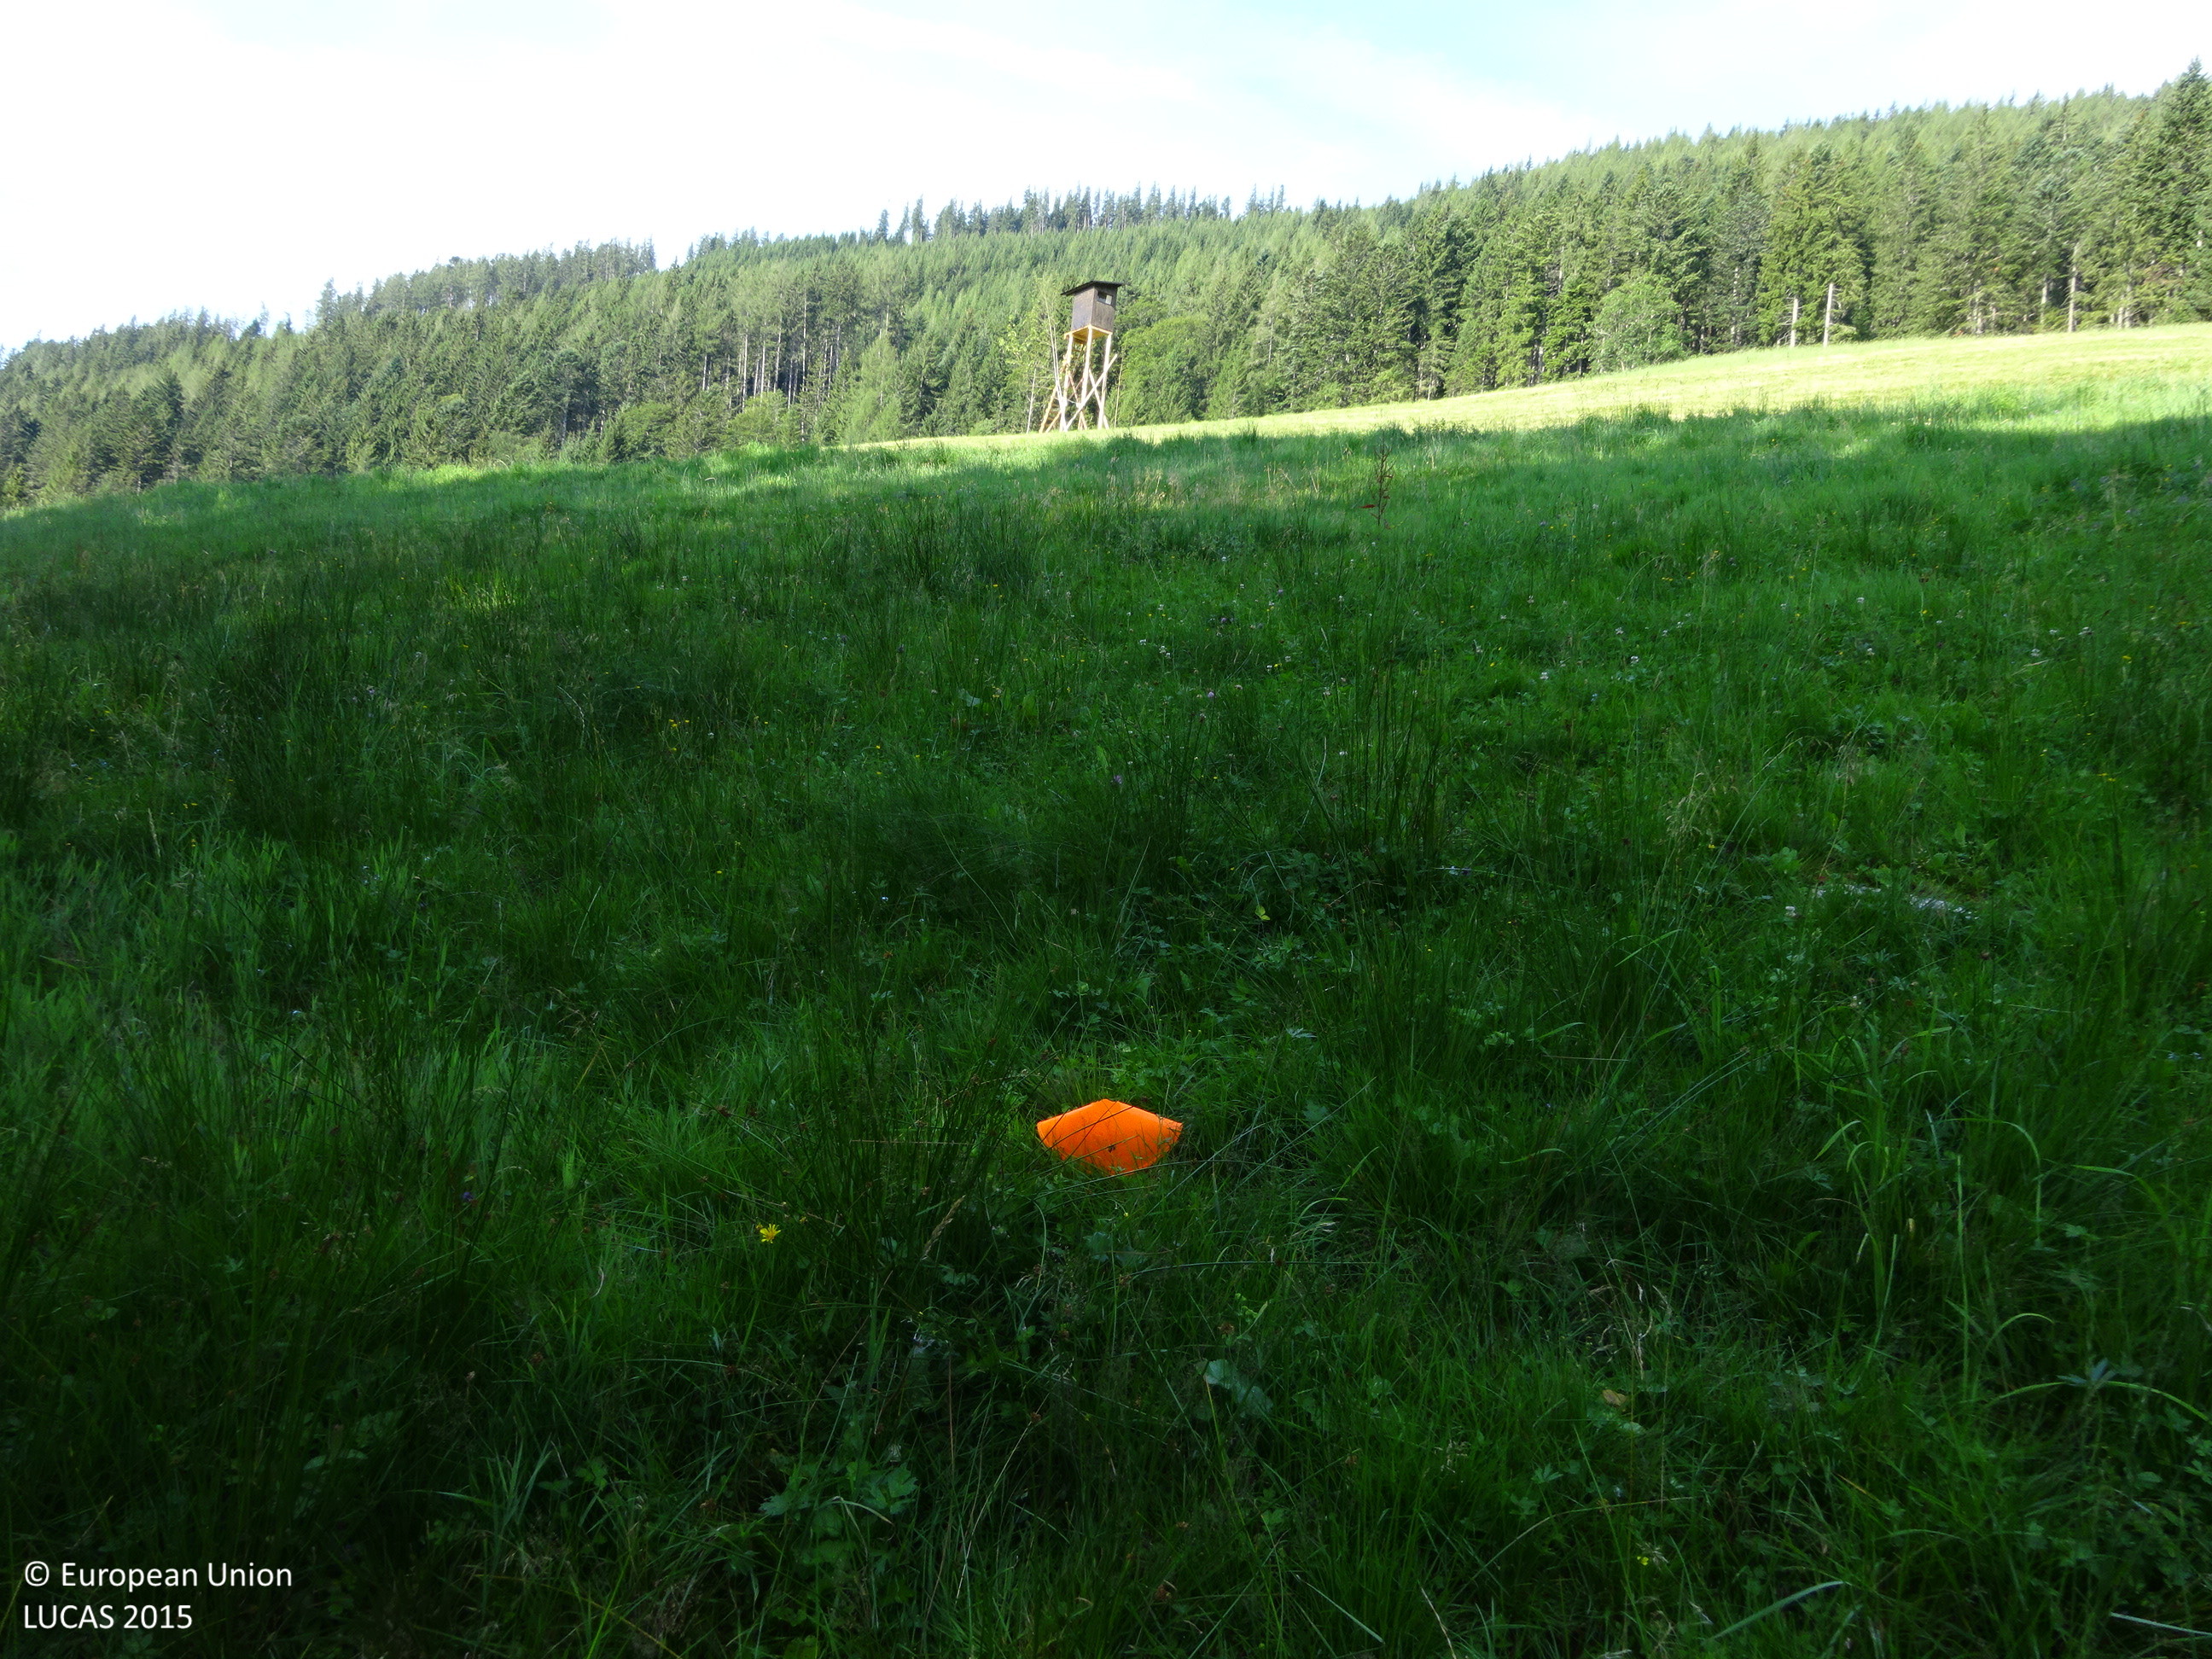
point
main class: Grassland
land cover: Grassland without tree/shrub cover
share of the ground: > 75 %
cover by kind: herbaceous plants 100 %
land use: Agriculture (excluding fallow land and kitchen gardens)
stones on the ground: < 10 %
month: August
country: AT
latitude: 47.5486
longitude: 15.7818
